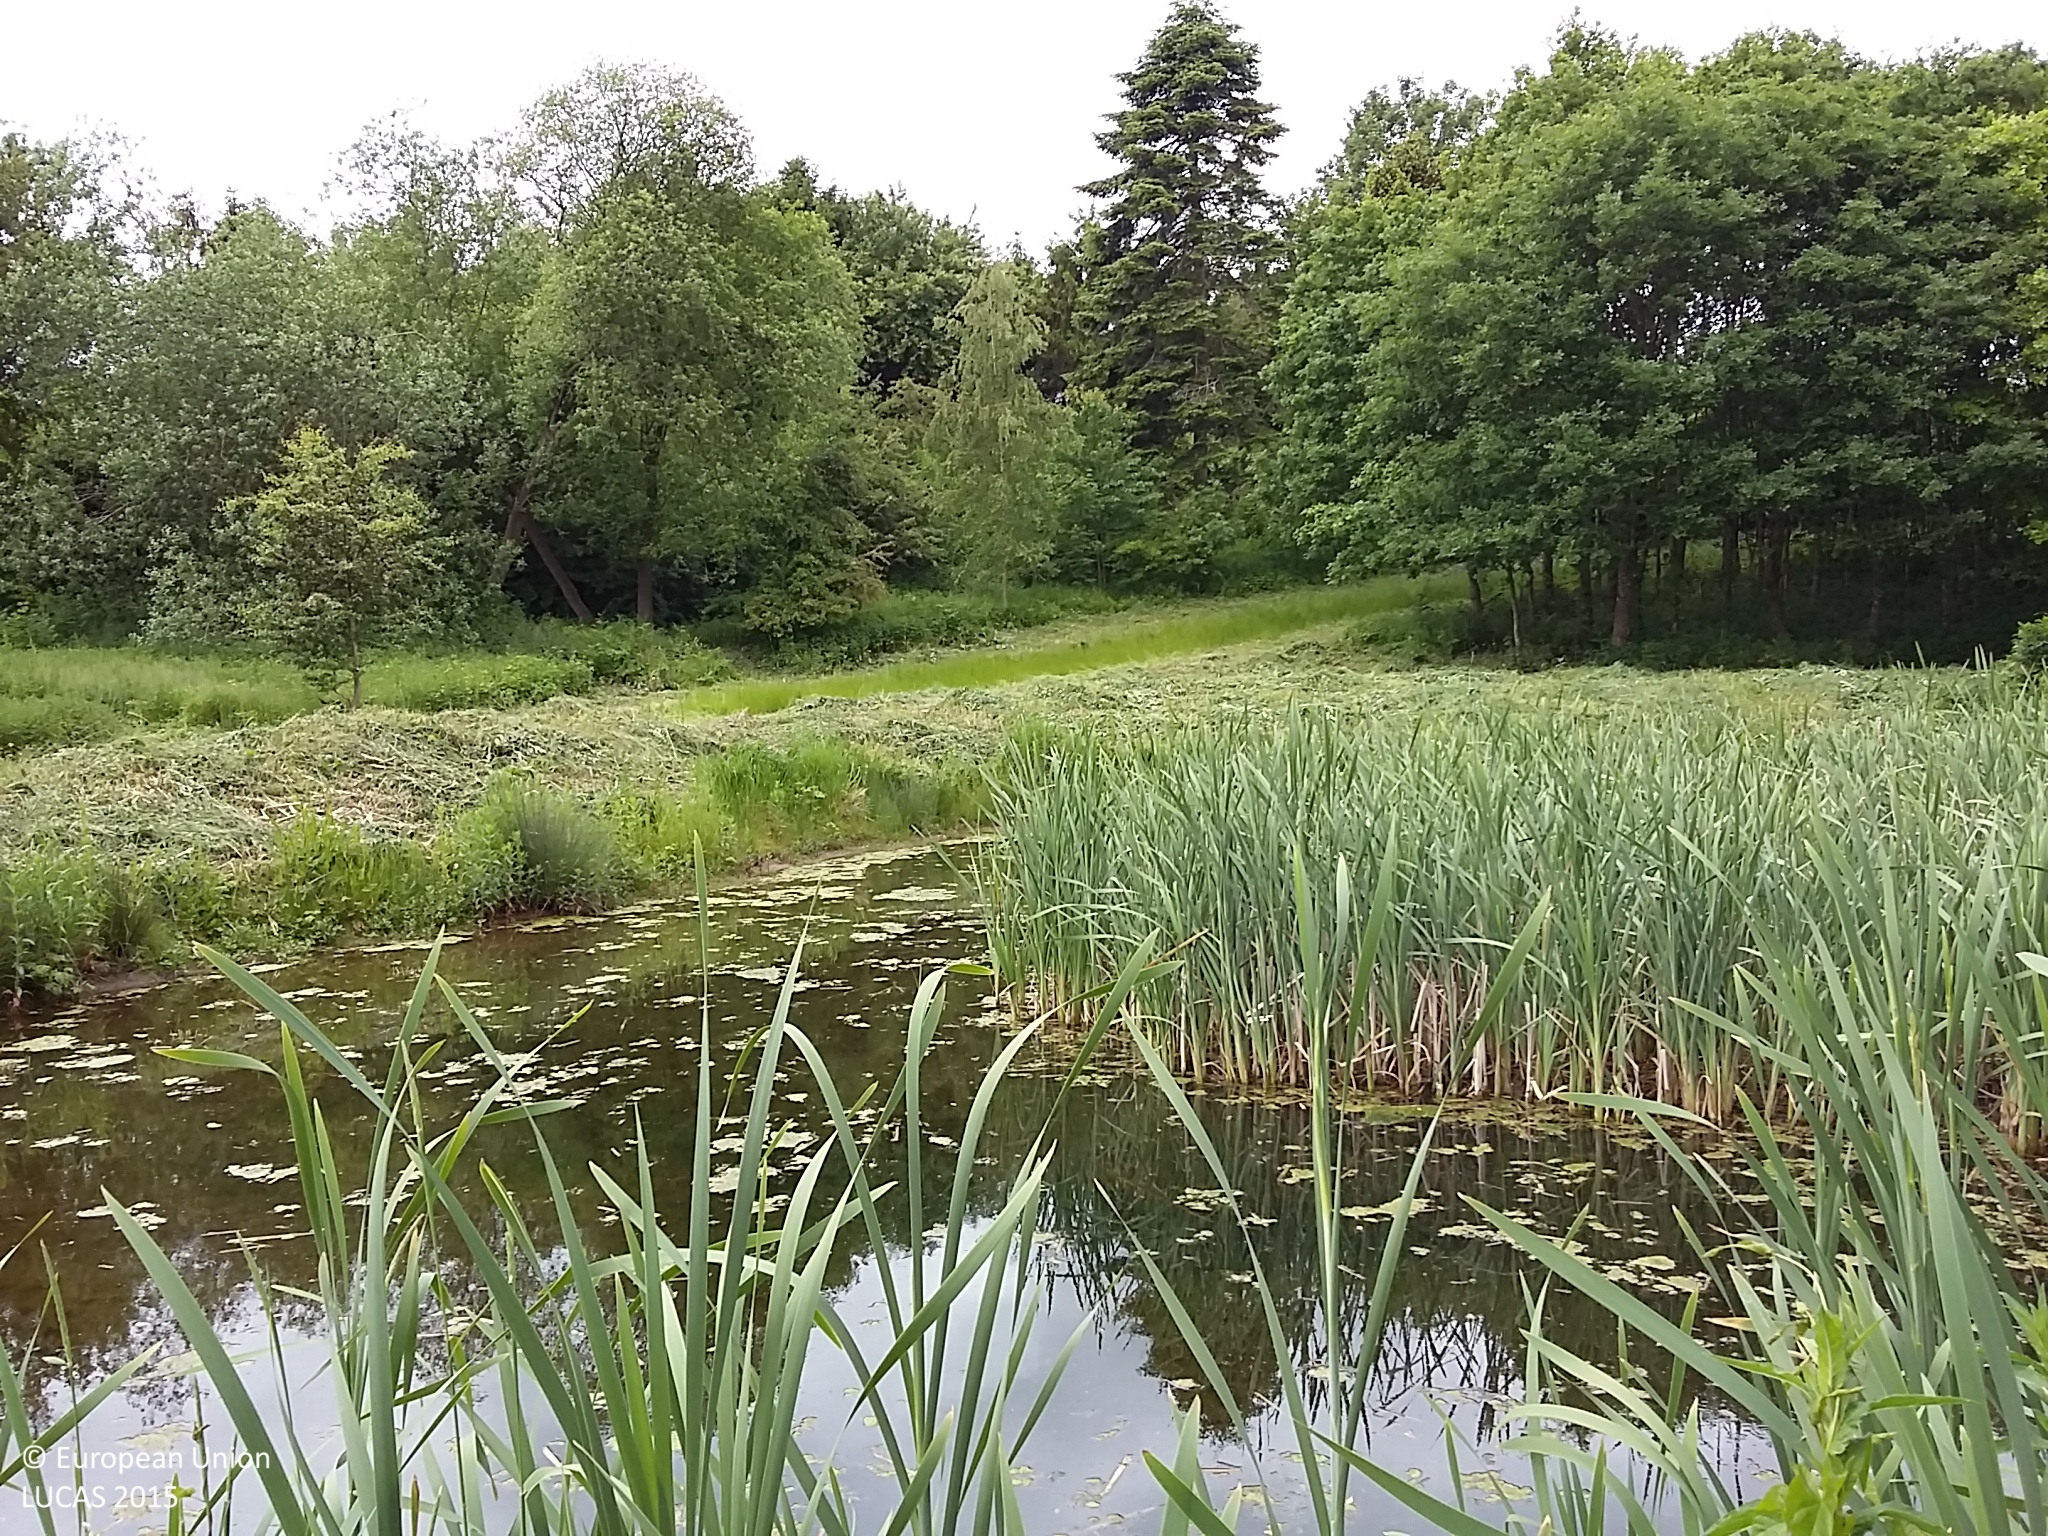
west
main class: Grassland
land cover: Spontaneously vegetated surfaces
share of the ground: > 75 %
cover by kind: herbaceous plants 100 %
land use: Semi-natural and natural areas not in use
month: June
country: DK
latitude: 55.2689
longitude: 10.7391
